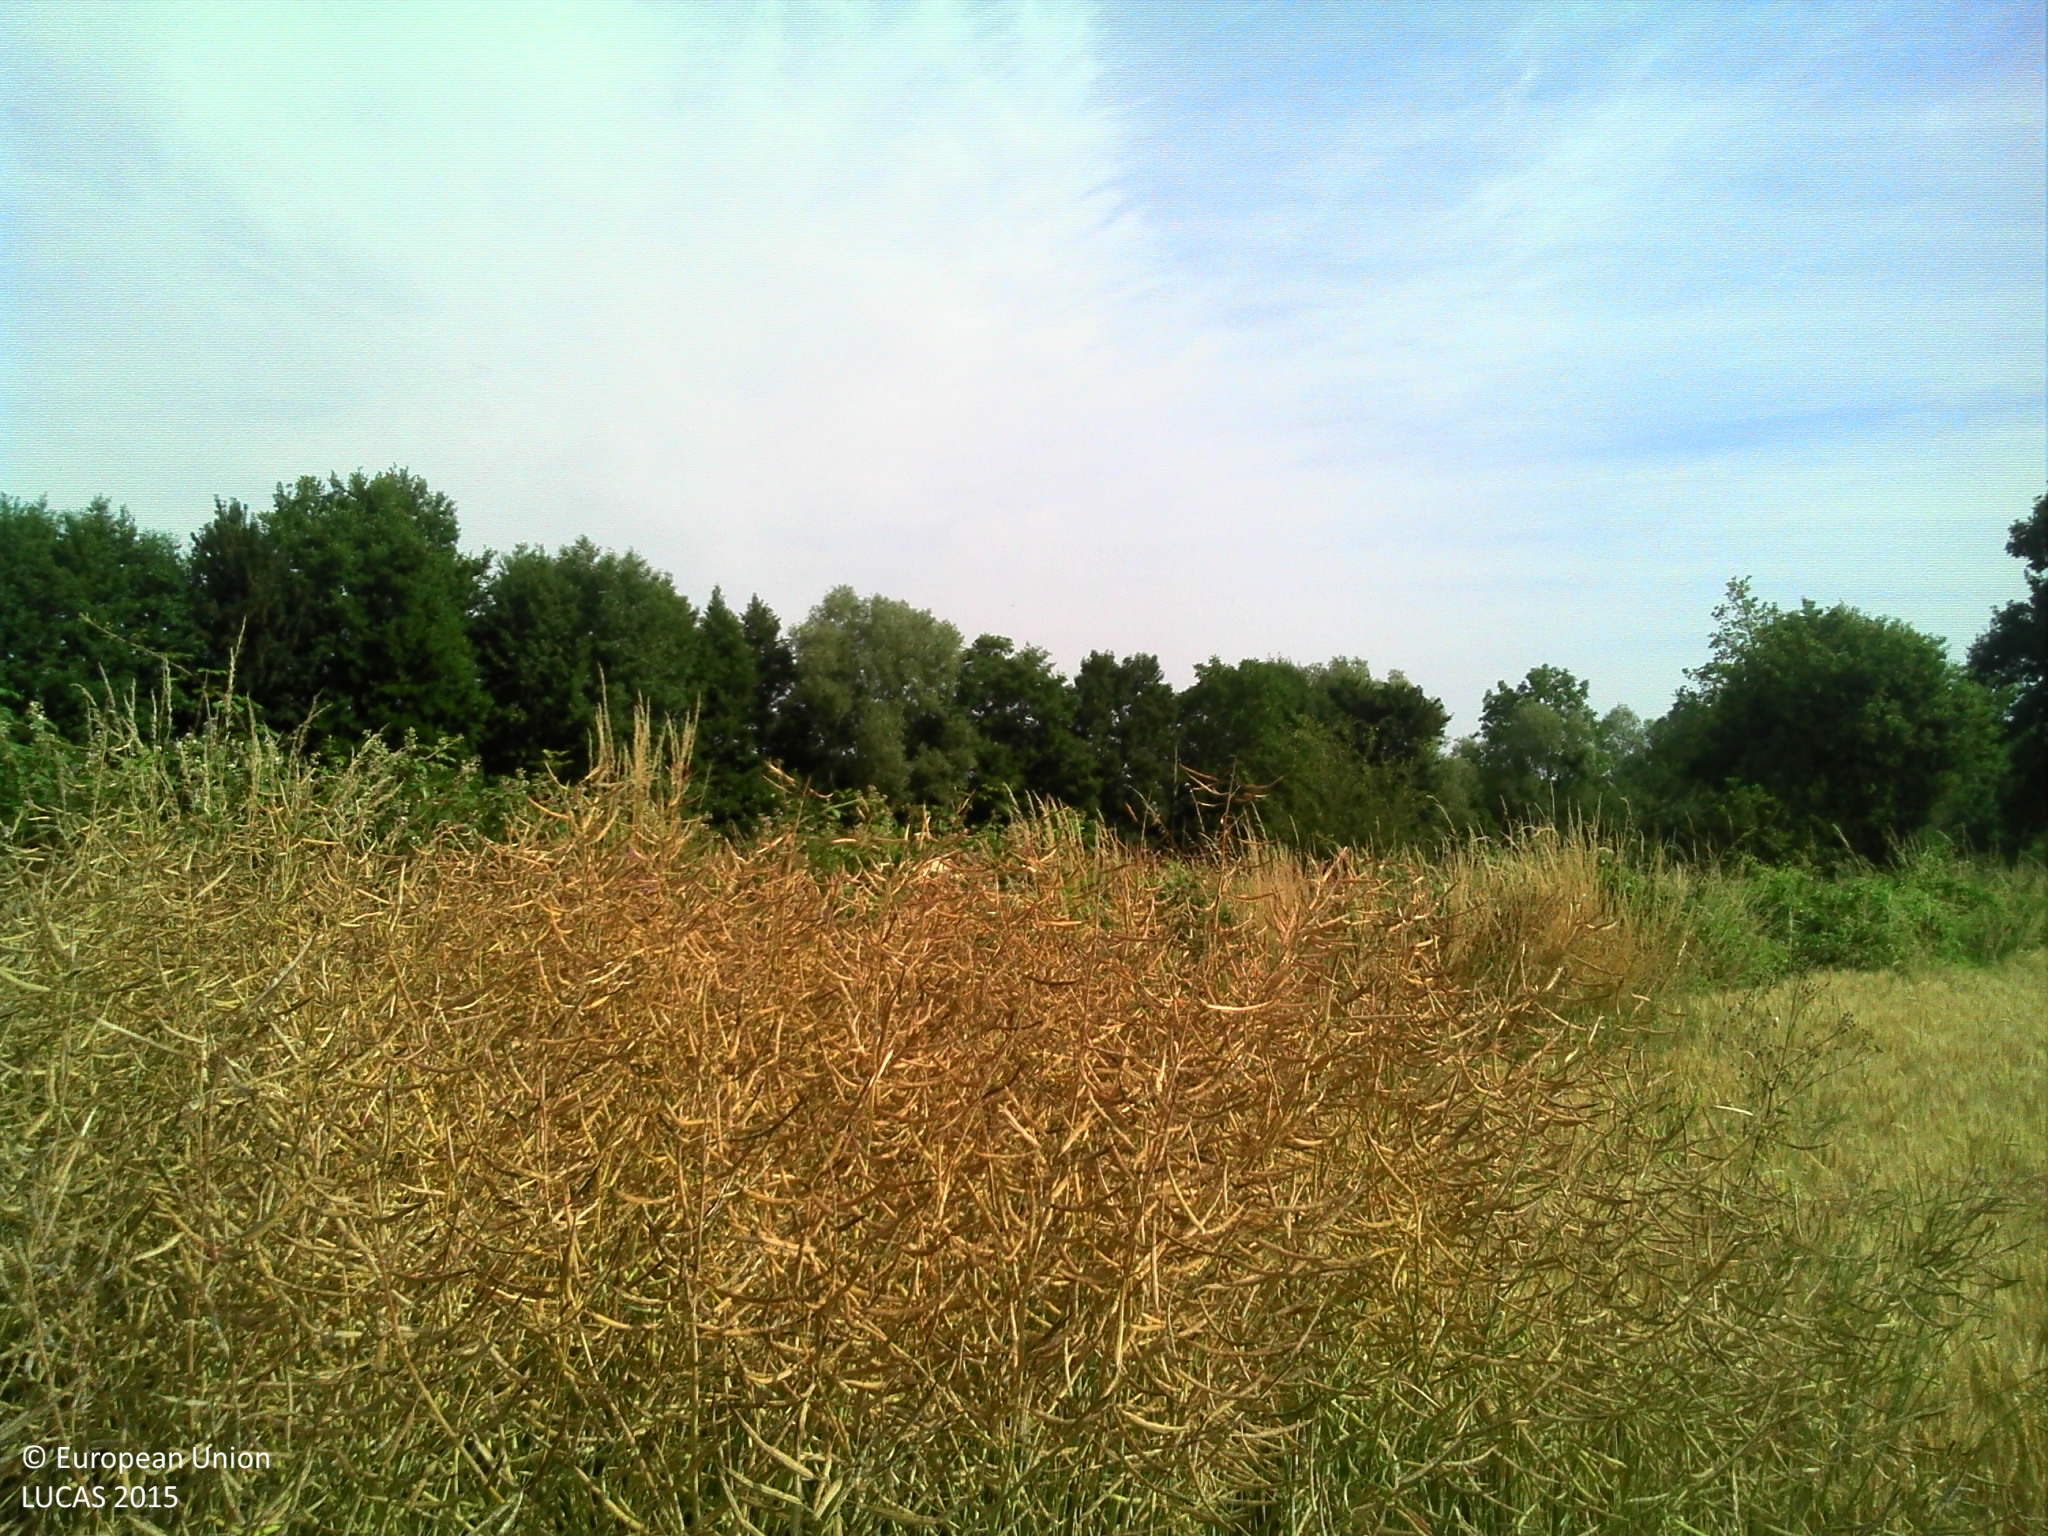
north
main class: Cropland
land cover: Rape and turnip rape
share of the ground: > 75 %
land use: Agriculture (excluding fallow land and kitchen gardens)
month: June
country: FR
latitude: 47.6693
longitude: 2.6273
